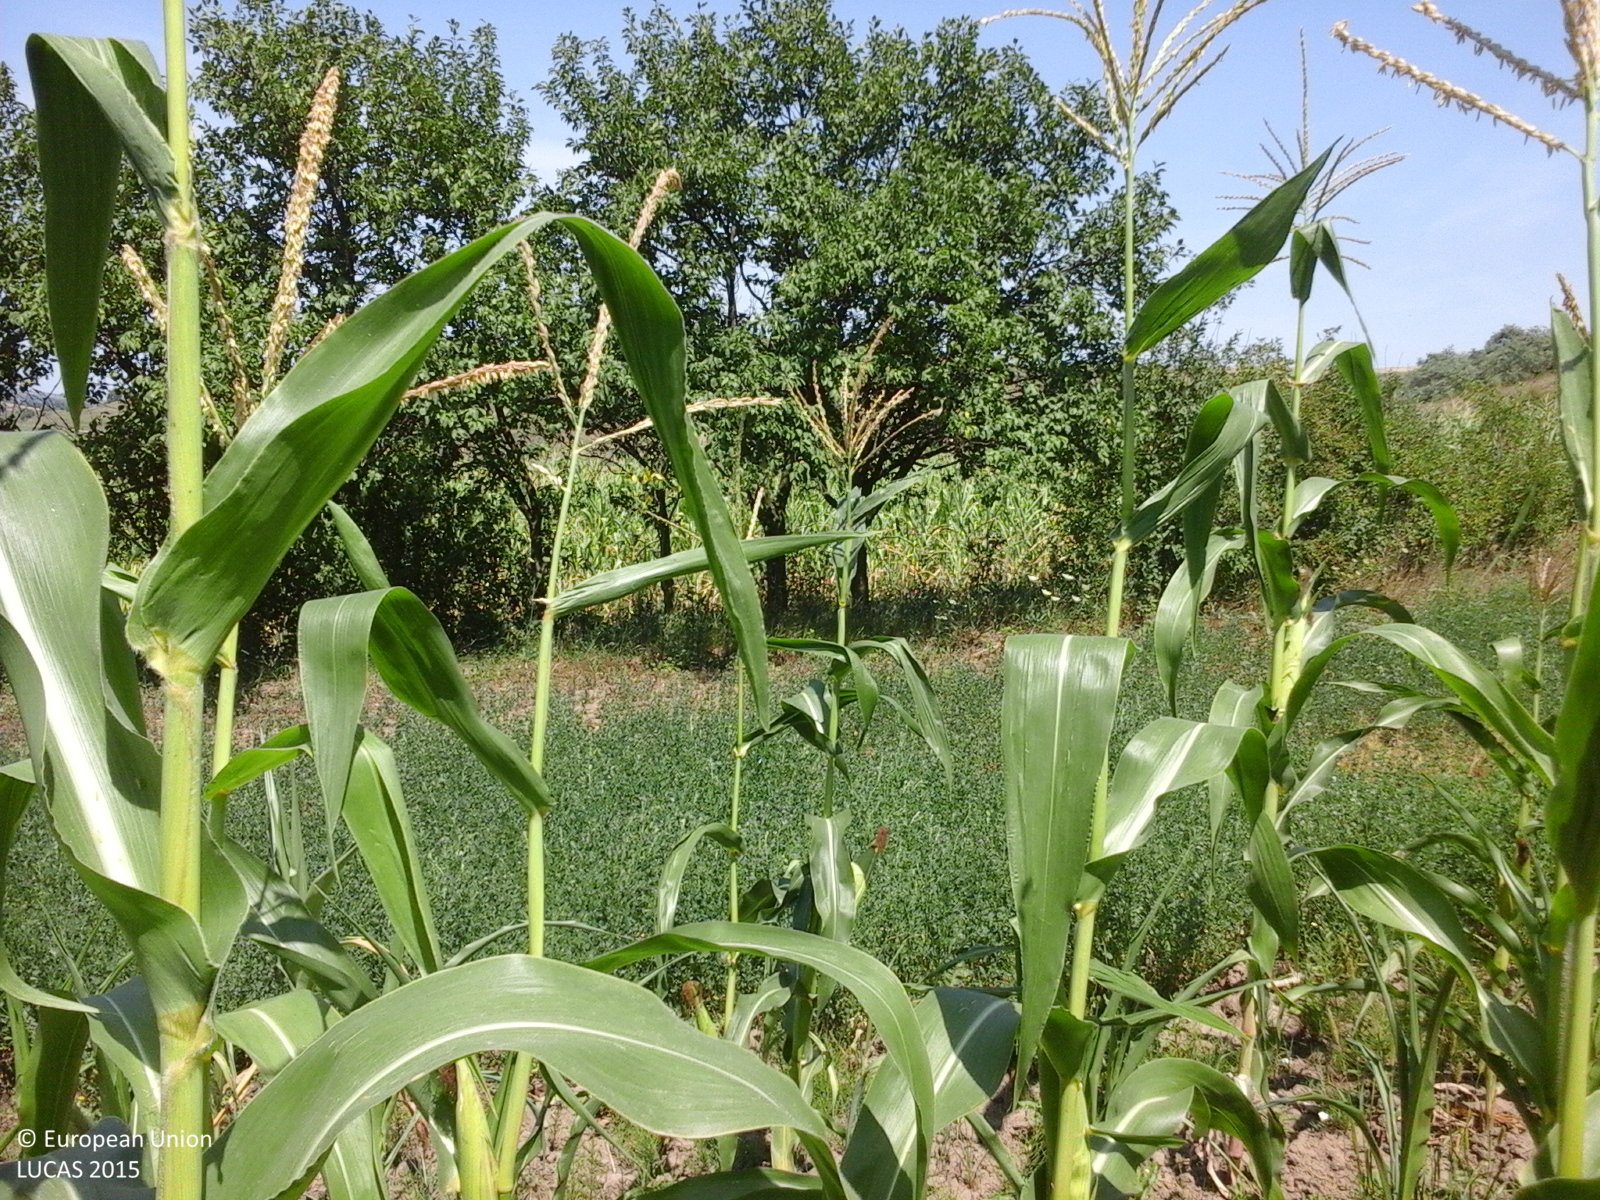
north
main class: Cropland
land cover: Maize
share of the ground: > 75 %
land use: Agriculture (excluding fallow land and kitchen gardens)
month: July
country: RO
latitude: 46.5063
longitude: 27.2128
